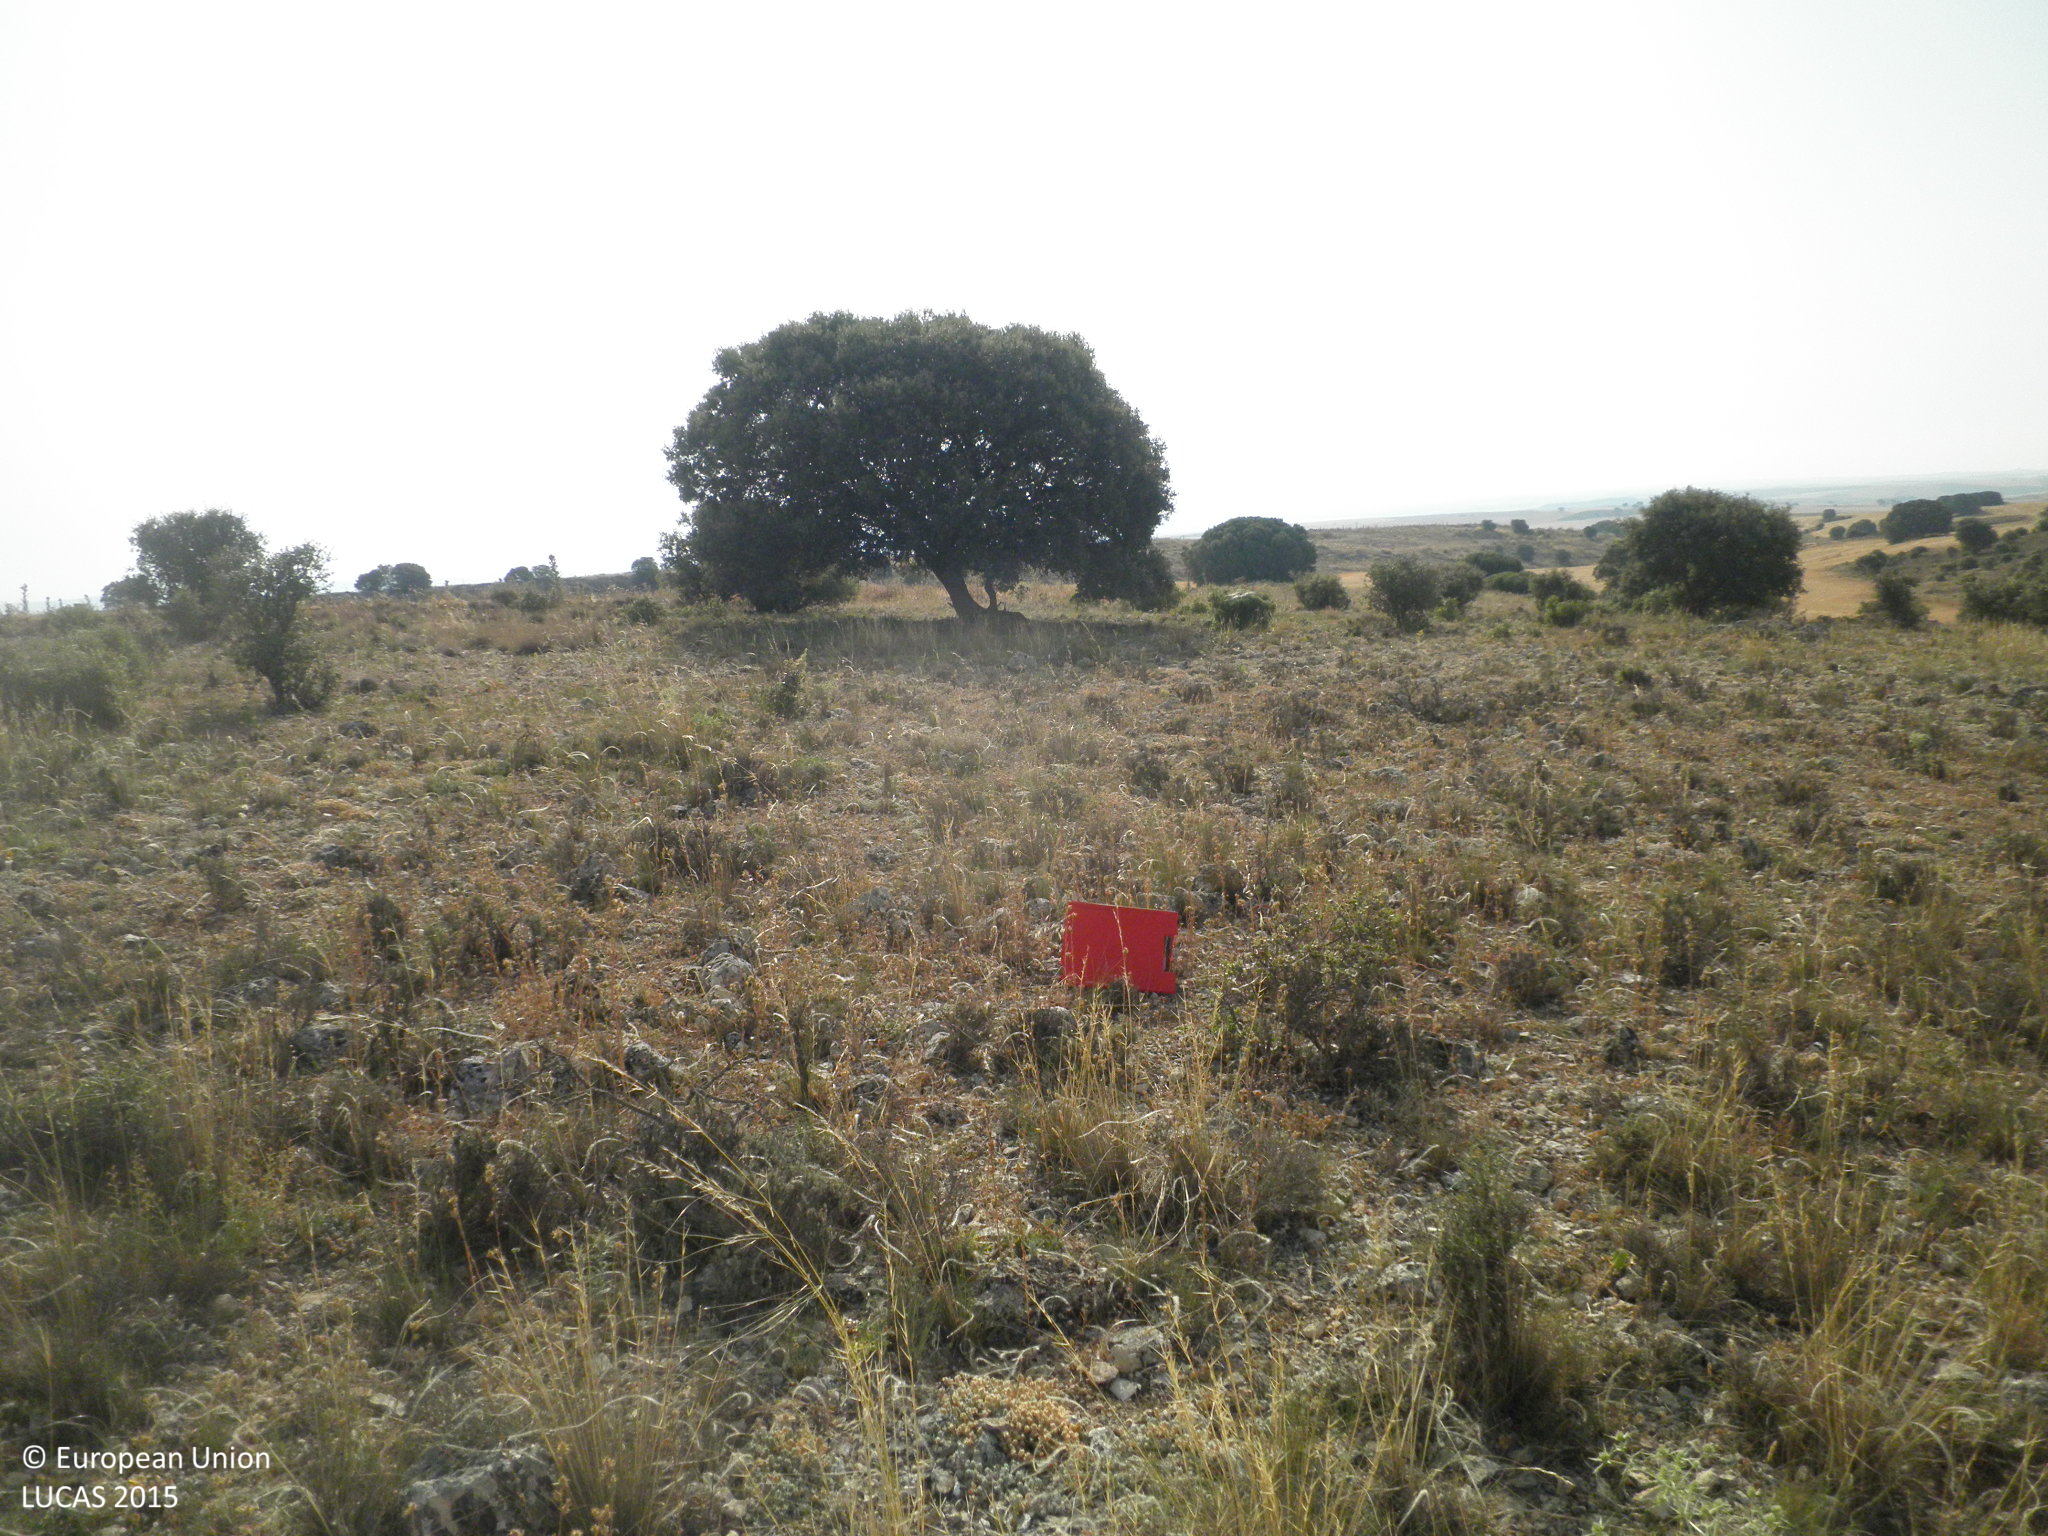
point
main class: Shrubland
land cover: Shrubland with sparse tree cover
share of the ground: 25 - 50 %
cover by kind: unconsolidated bare surface 45 %, shrubs 30 %, herbaceous plants 20 %, broadleaved forest trees 5 %
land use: Semi-natural and natural areas not in use
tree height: < 5 m
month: July
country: ES
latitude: 39.4904
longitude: -2.4411
